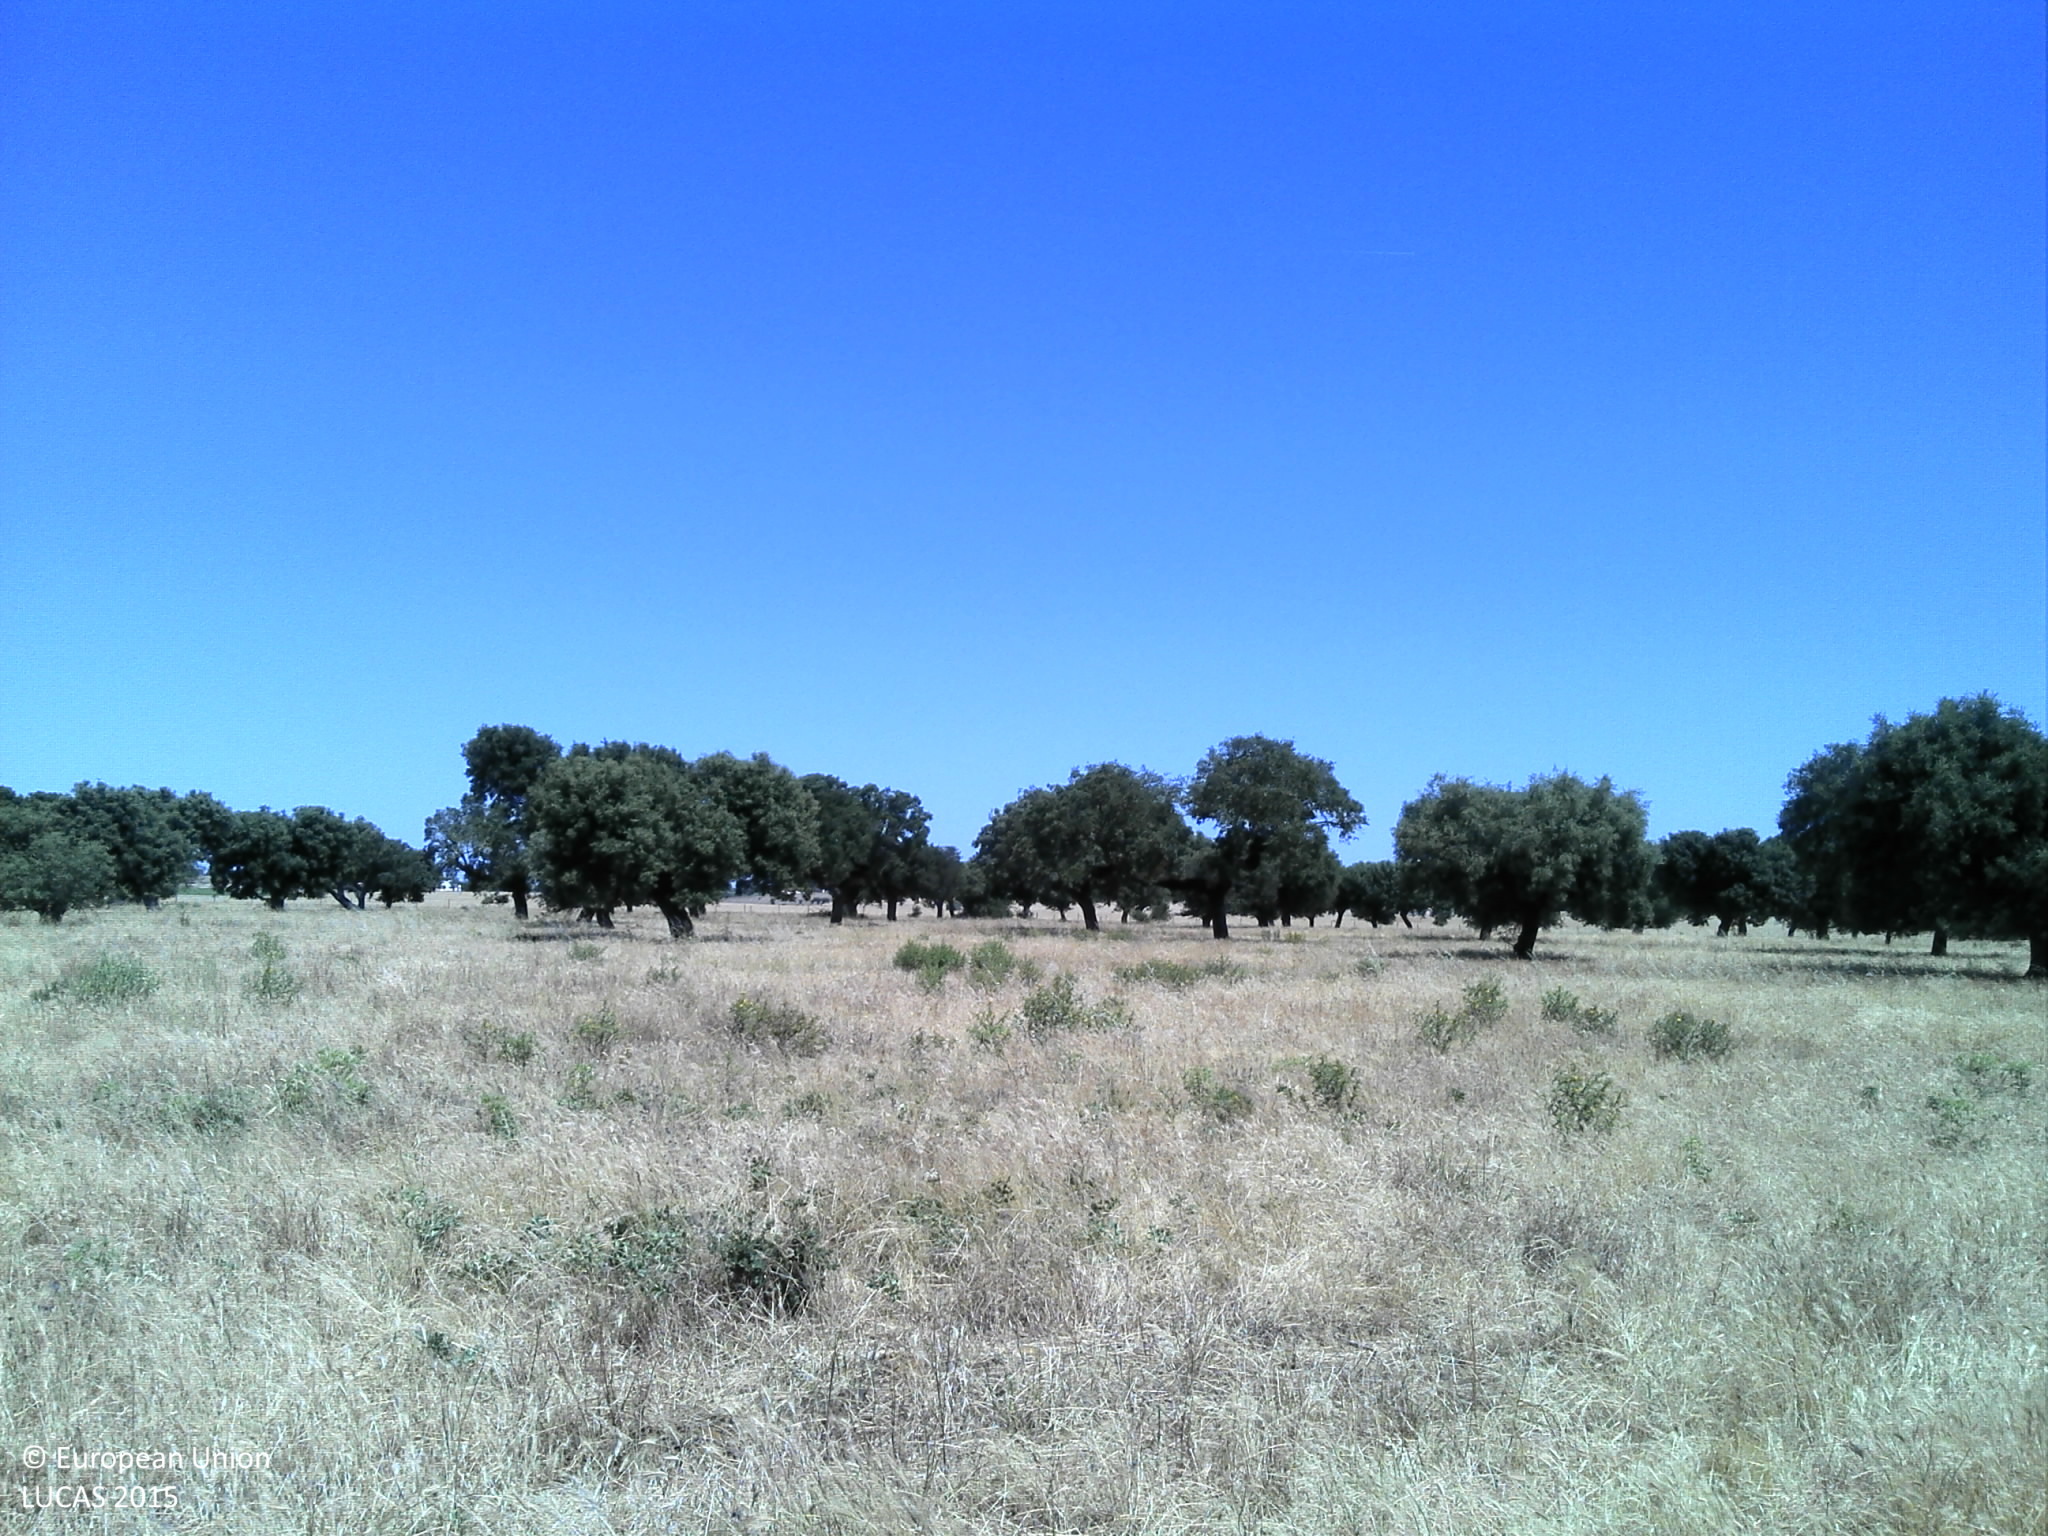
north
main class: Woodland
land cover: Broadleaved woodland
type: broadleaved evergreen forest
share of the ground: 10 - 25 %
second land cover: Grassland without tree/shrub cover
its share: 50 - 75 %
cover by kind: herbaceous plants 70 %, unconsolidated bare surface 20 %, broadleaved forest trees 10 %
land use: Forestry
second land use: Agriculture (excluding fallow land and kitchen gardens)
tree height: > 5 m
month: May
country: PT
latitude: 39.0077
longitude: -7.6285
